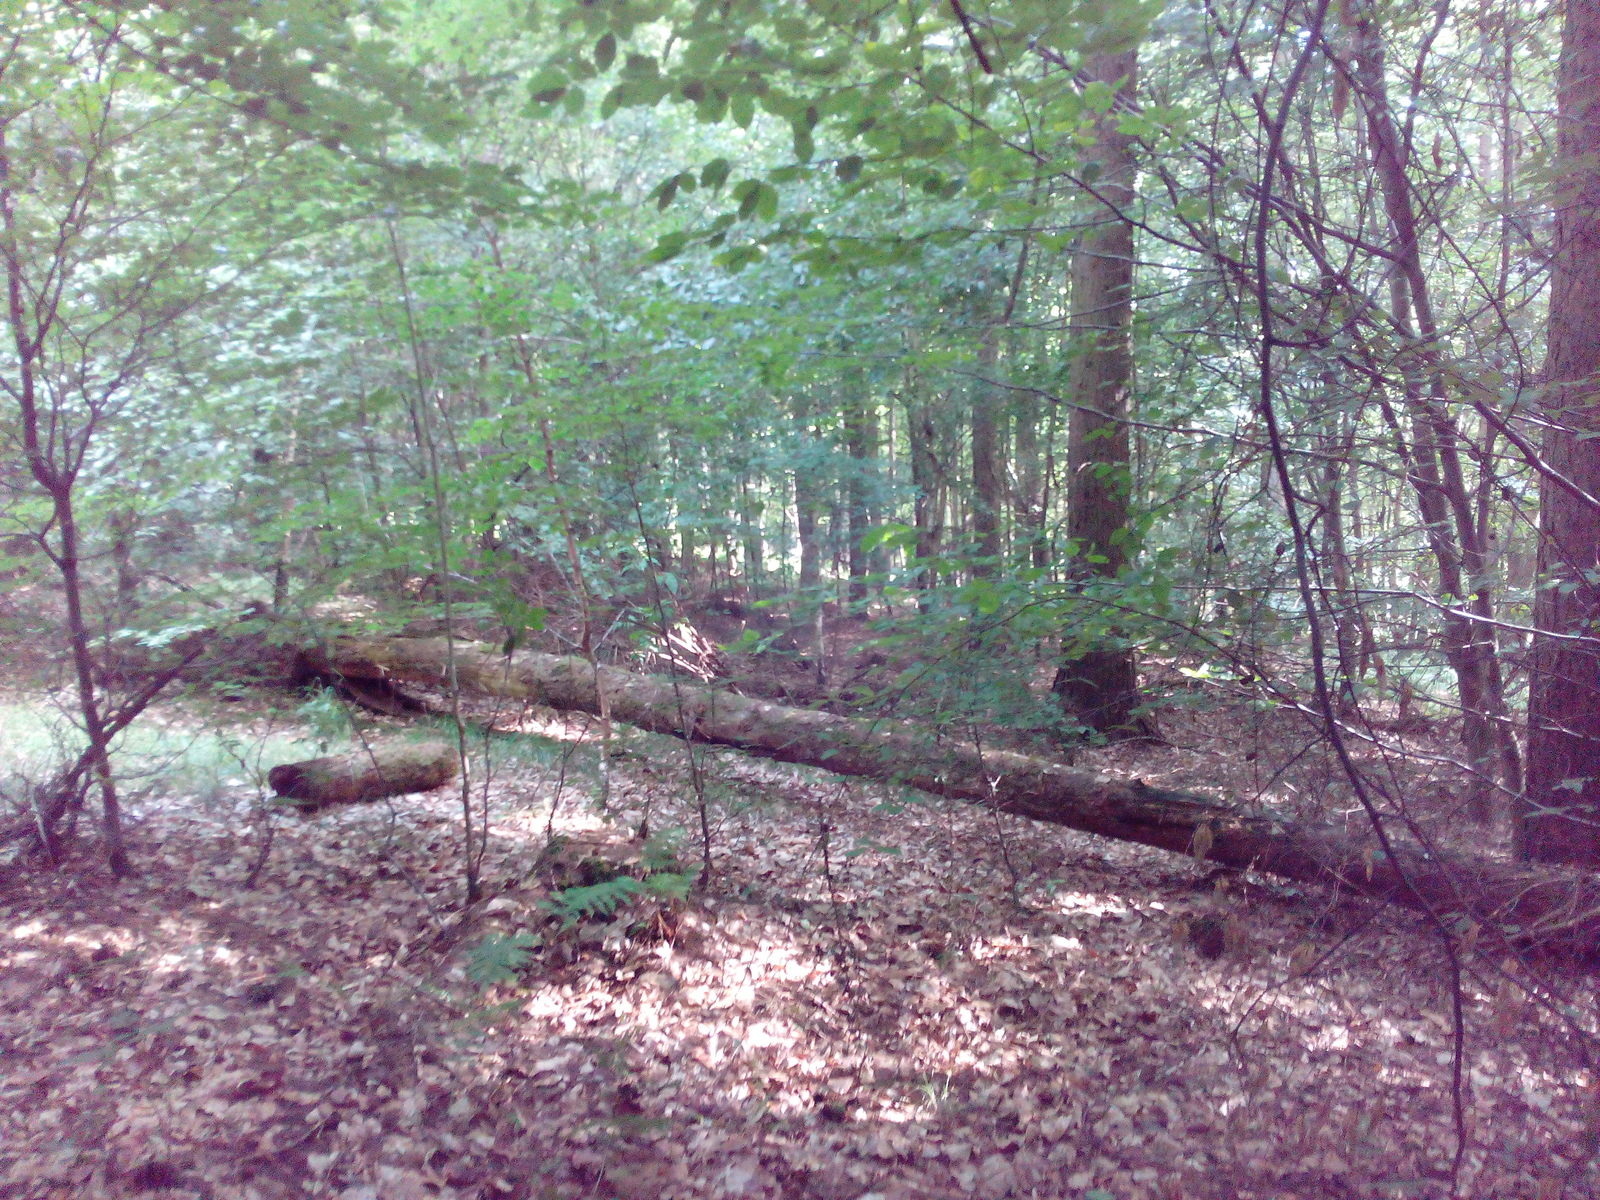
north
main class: Woodland
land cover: Other mixed woodland
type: hemiboreal forest and nemoral coniferous forest and mixed broadleaved-coniferous forest
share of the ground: 50 - 75 %
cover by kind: broadleaved forest trees 70 %, coniferous forest trees 30 %
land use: Forestry
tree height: > 5 m
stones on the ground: < 10 %
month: July
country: DE
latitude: 51.3130
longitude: 10.9610
